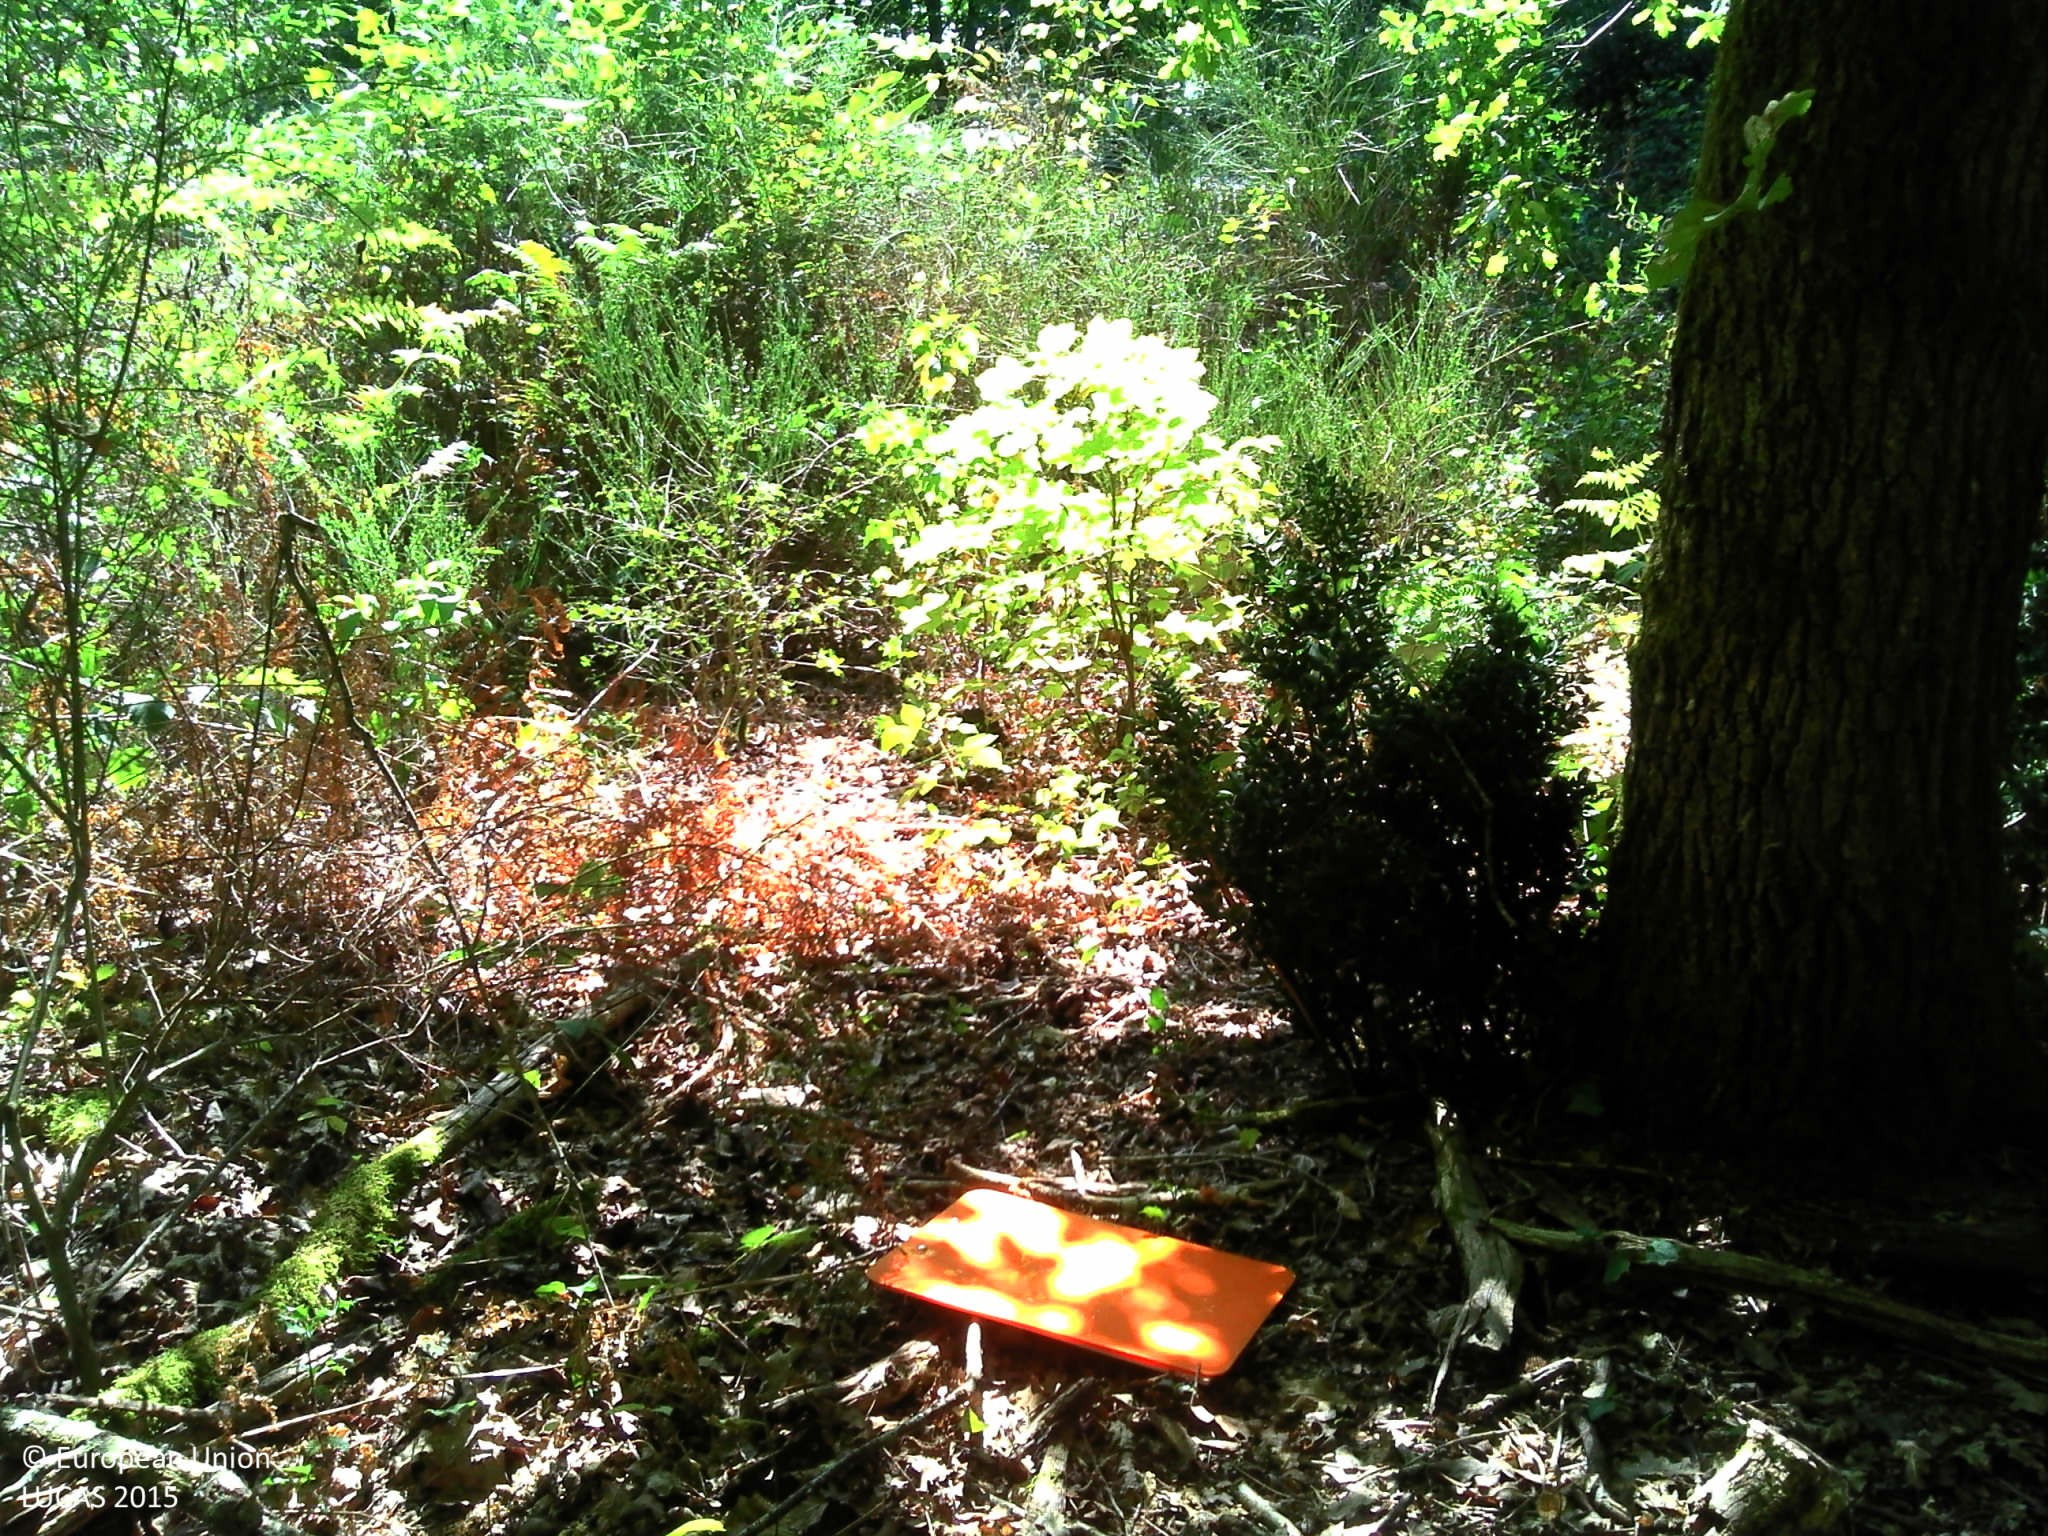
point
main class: Woodland
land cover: Broadleaved woodland
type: mesophytic deciduous forest
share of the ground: > 75 %
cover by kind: broadleaved forest trees 80 %, shrubs 10 %, herbaceous plants 5 %, lichens and mosses 5 %
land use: Forestry
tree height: > 5 m
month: September
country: FR
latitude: 48.3457
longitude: 2.7453
